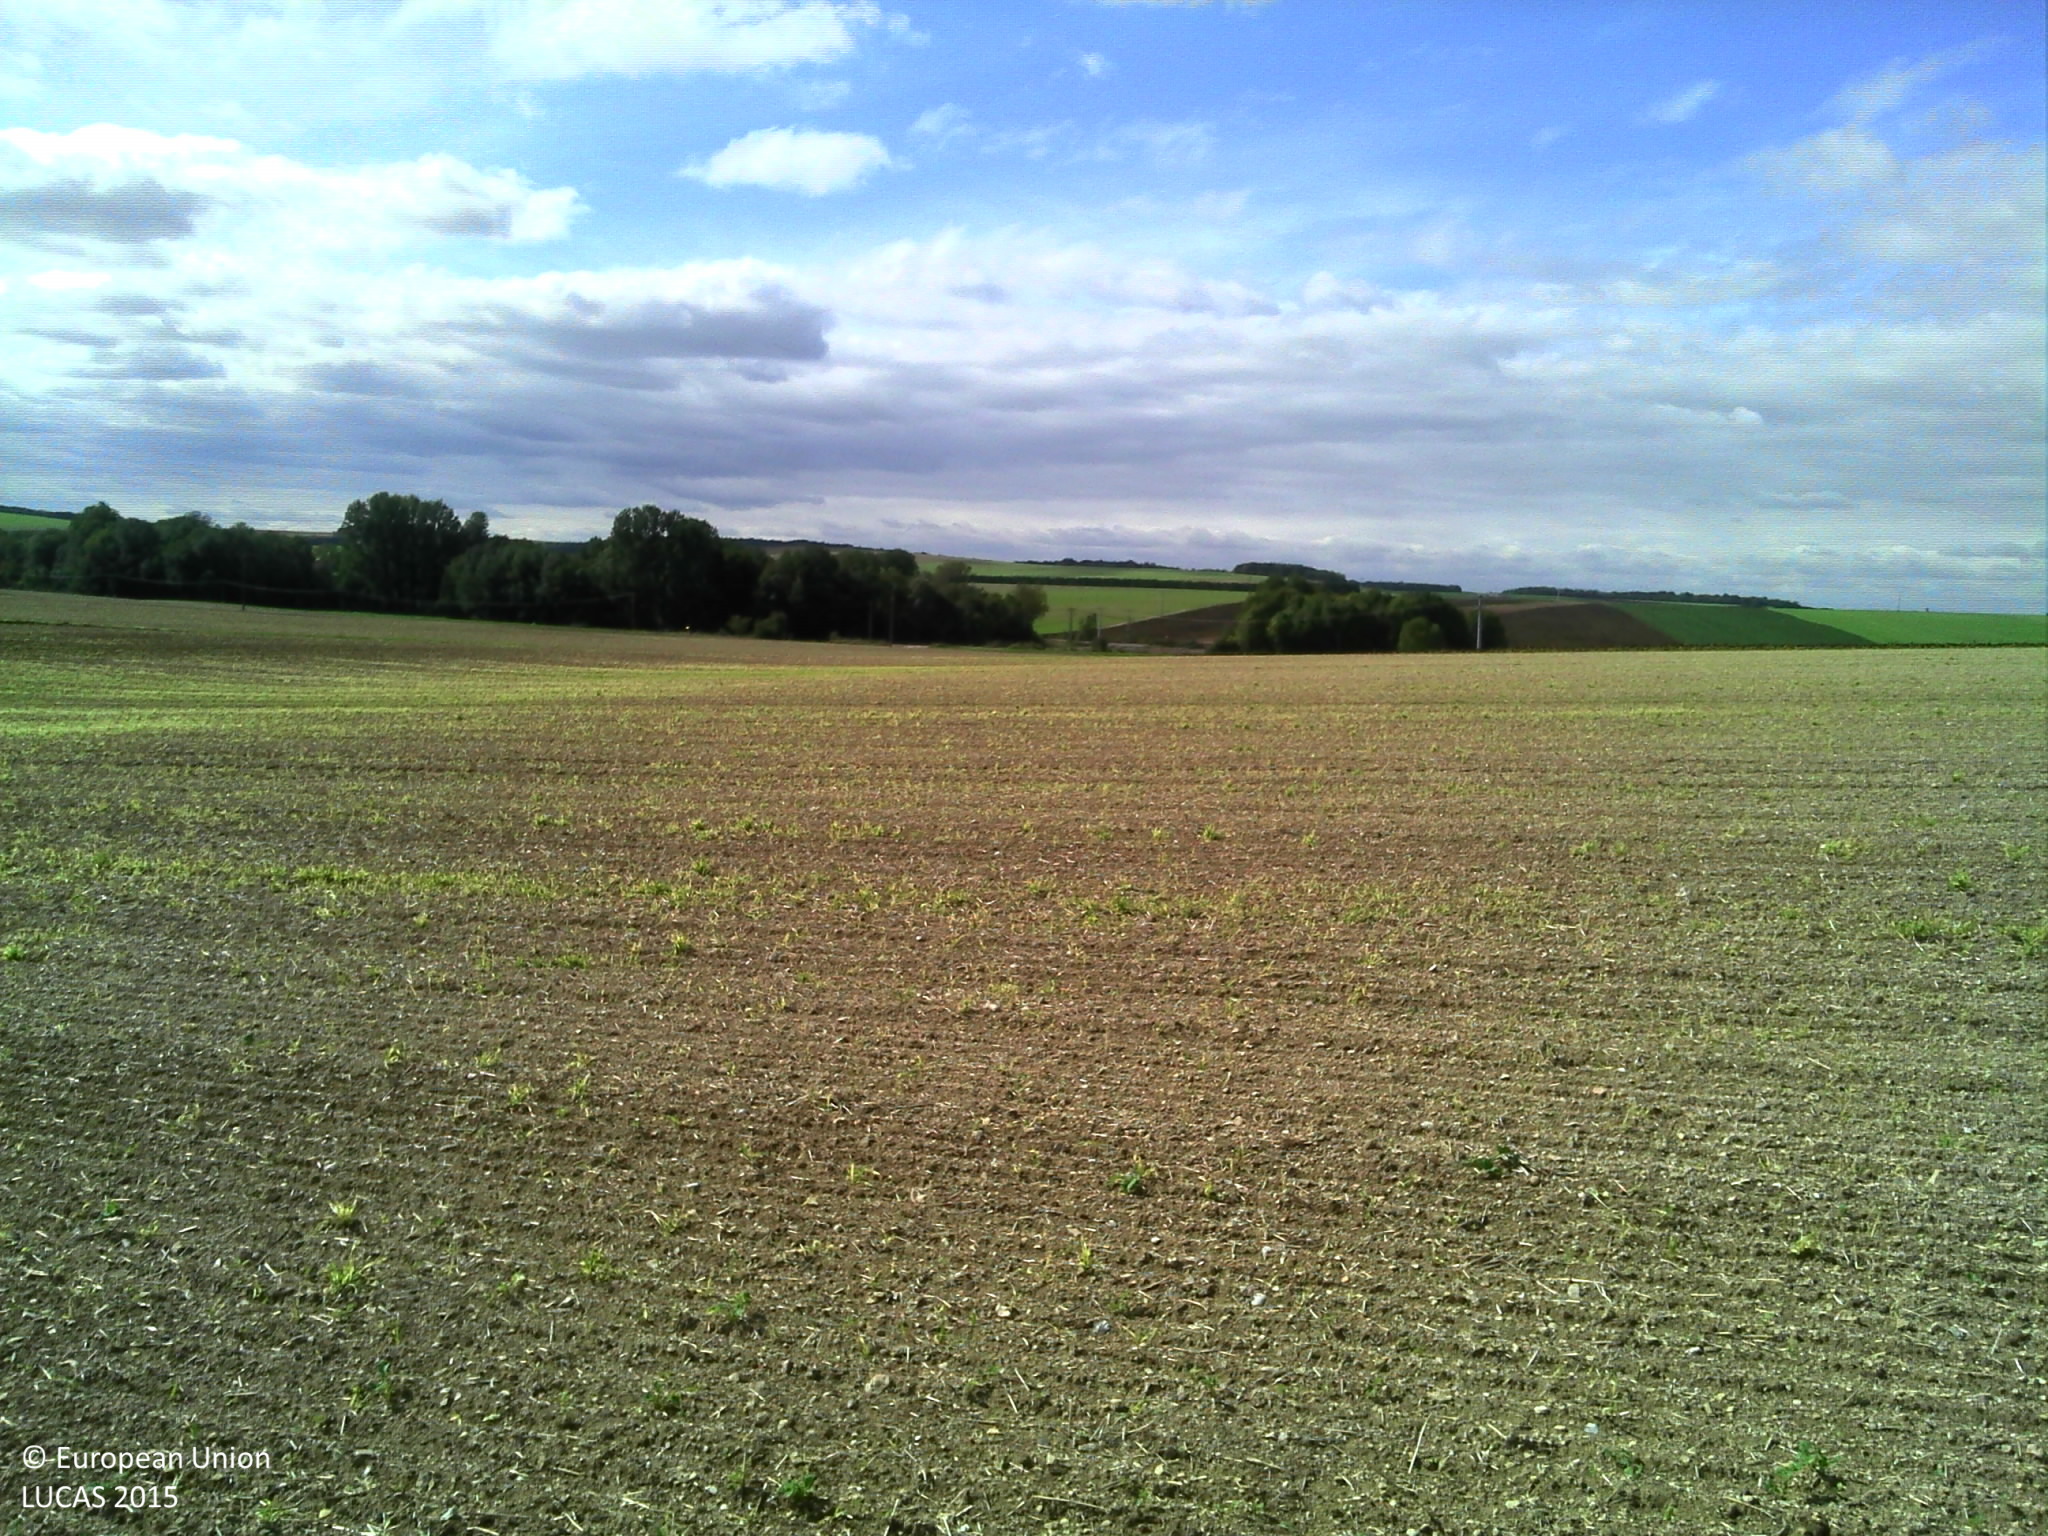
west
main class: Cropland
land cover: Rape and turnip rape
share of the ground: < 10 %
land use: Agriculture (excluding fallow land and kitchen gardens)
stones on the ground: < 10 %
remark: Tilled/Sowed
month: September
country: FR
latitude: 48.3036
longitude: 3.8344
